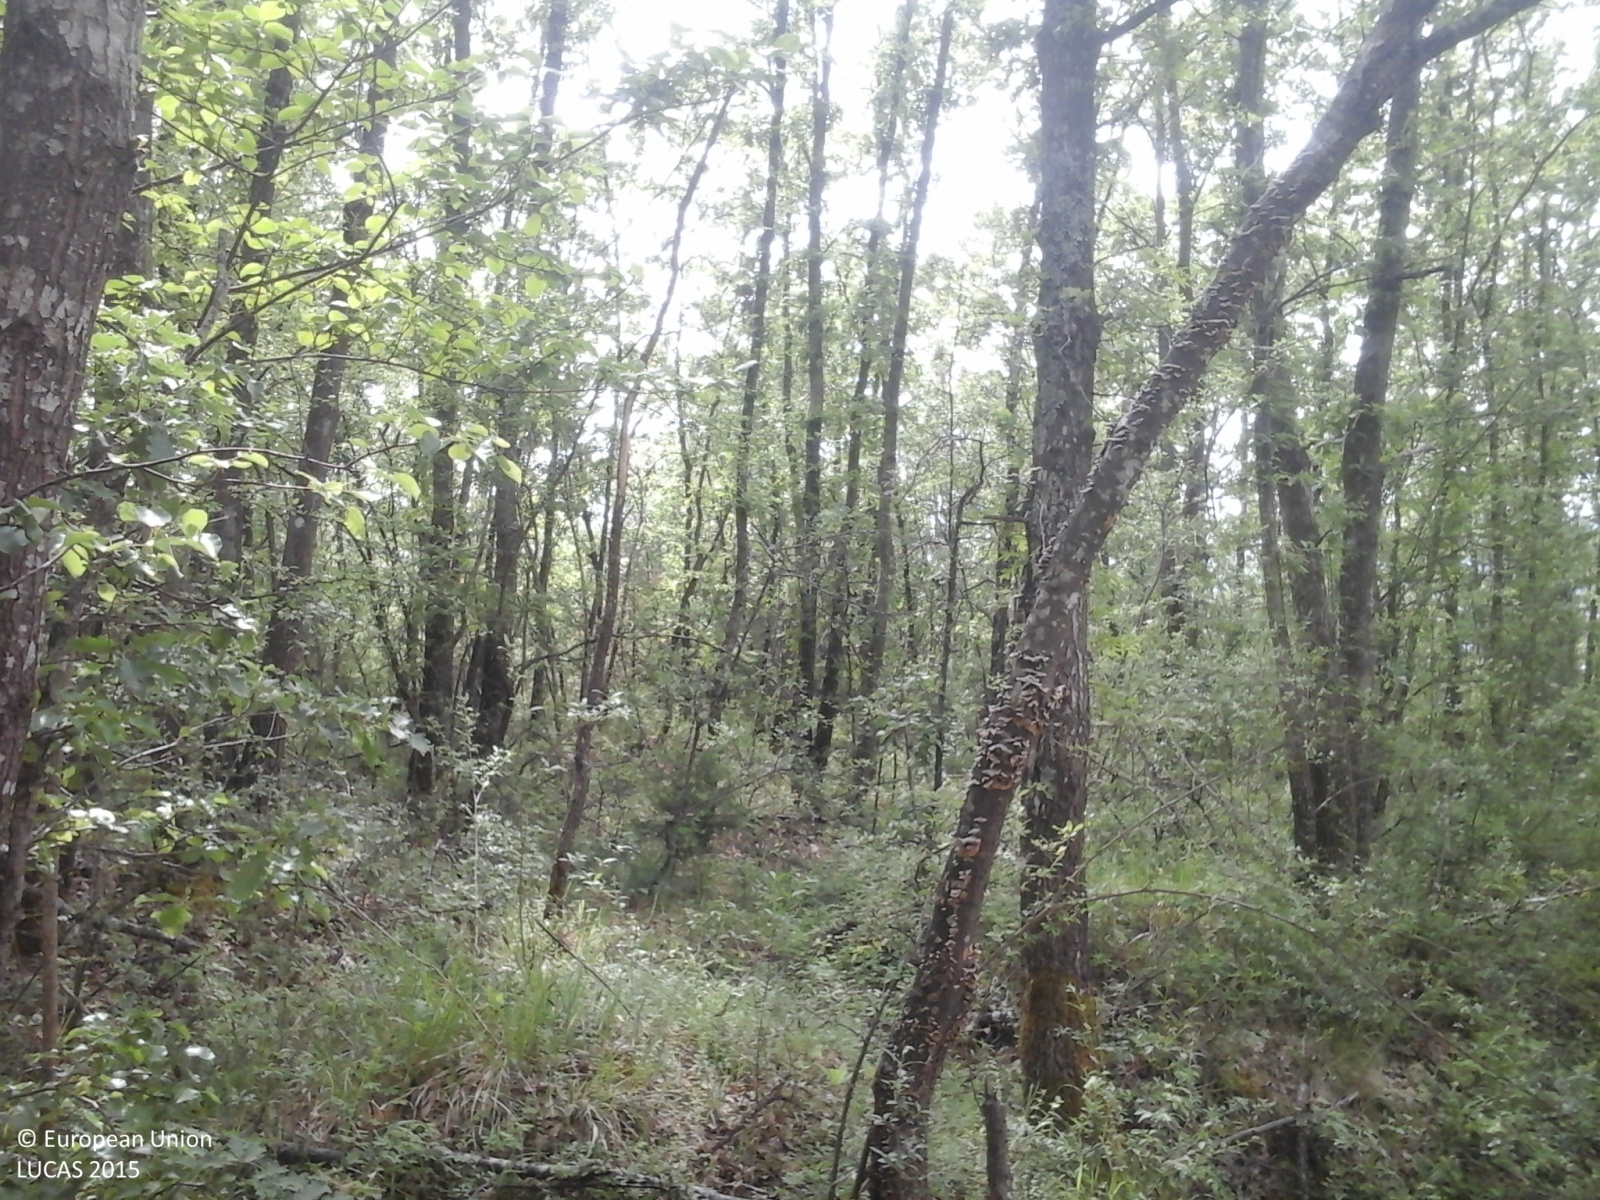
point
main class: Woodland
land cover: Broadleaved woodland
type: thermophilous deciduous forest
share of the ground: > 75 %
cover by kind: broadleaved forest trees 90 %, shrubs 5 %, herbaceous plants 5 %
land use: Forestry
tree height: > 5 m
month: May
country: IT
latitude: 44.2388
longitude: 10.8619
